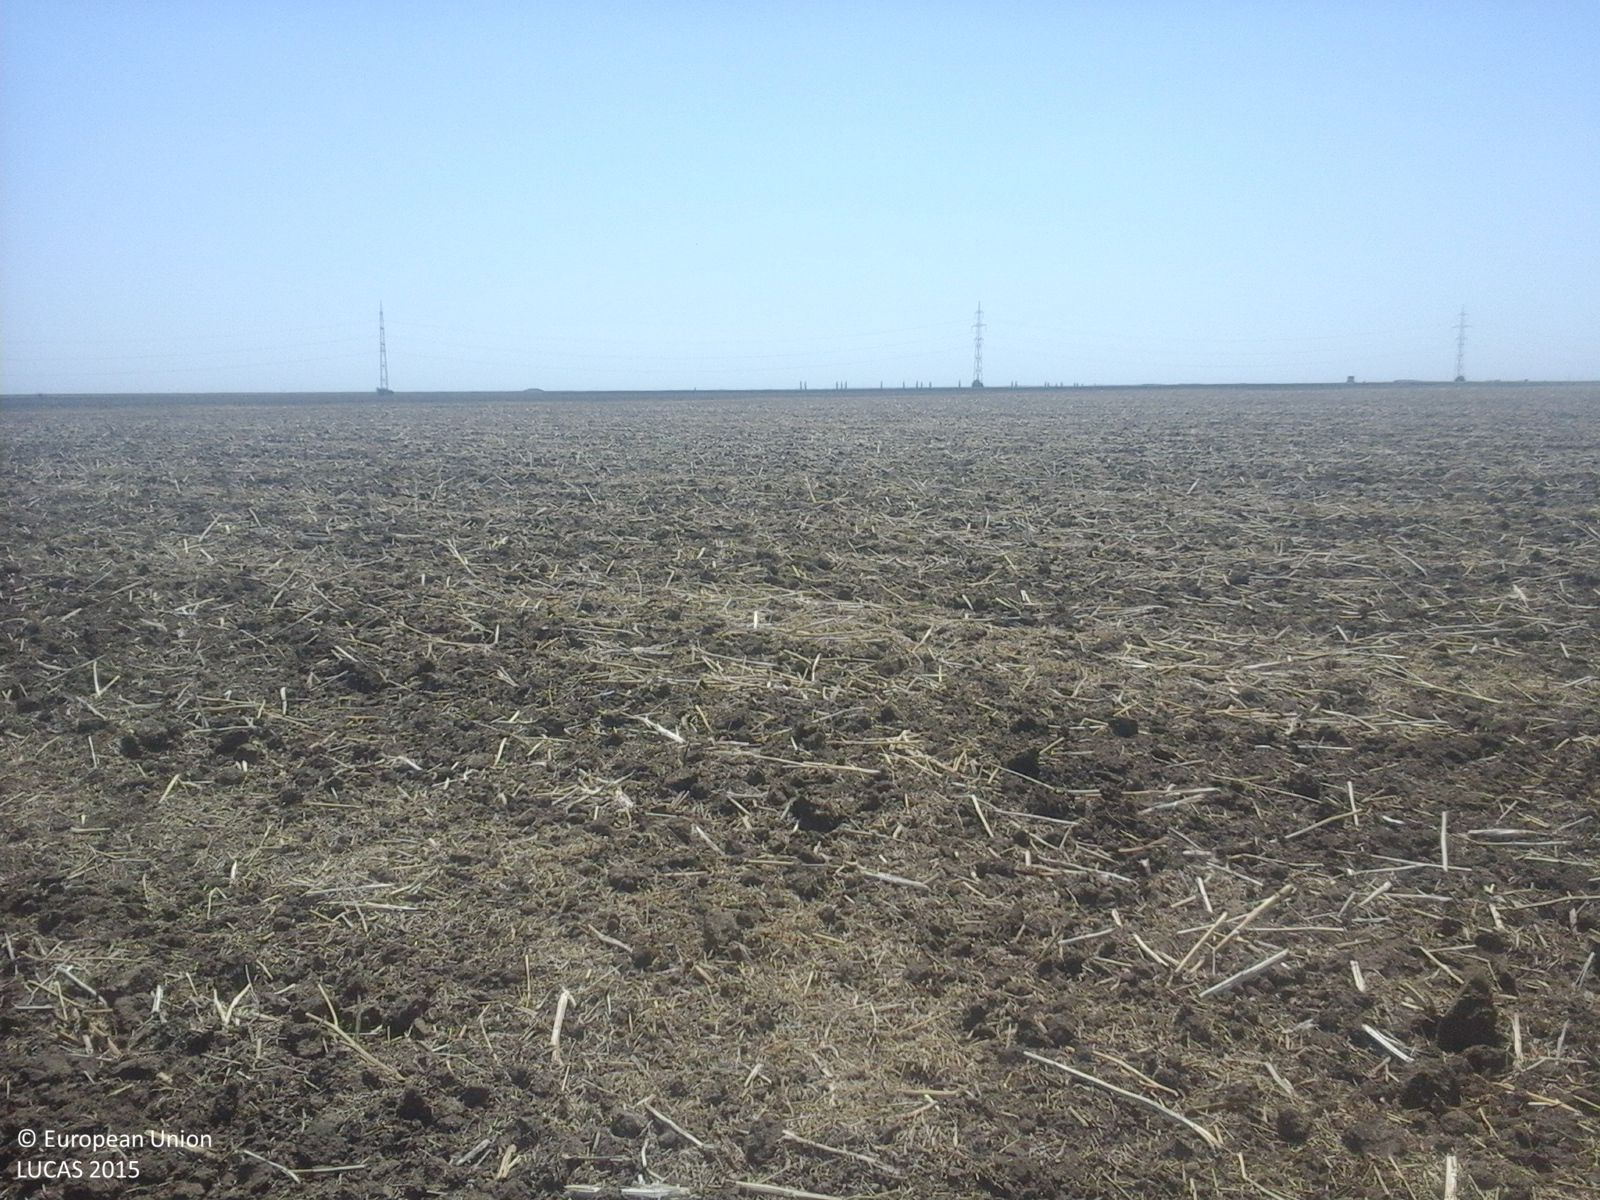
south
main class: Cropland
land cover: Rape and turnip rape
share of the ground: < 10 %
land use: Agriculture (excluding fallow land and kitchen gardens)
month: July
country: RO
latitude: 44.4139
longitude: 26.7358
